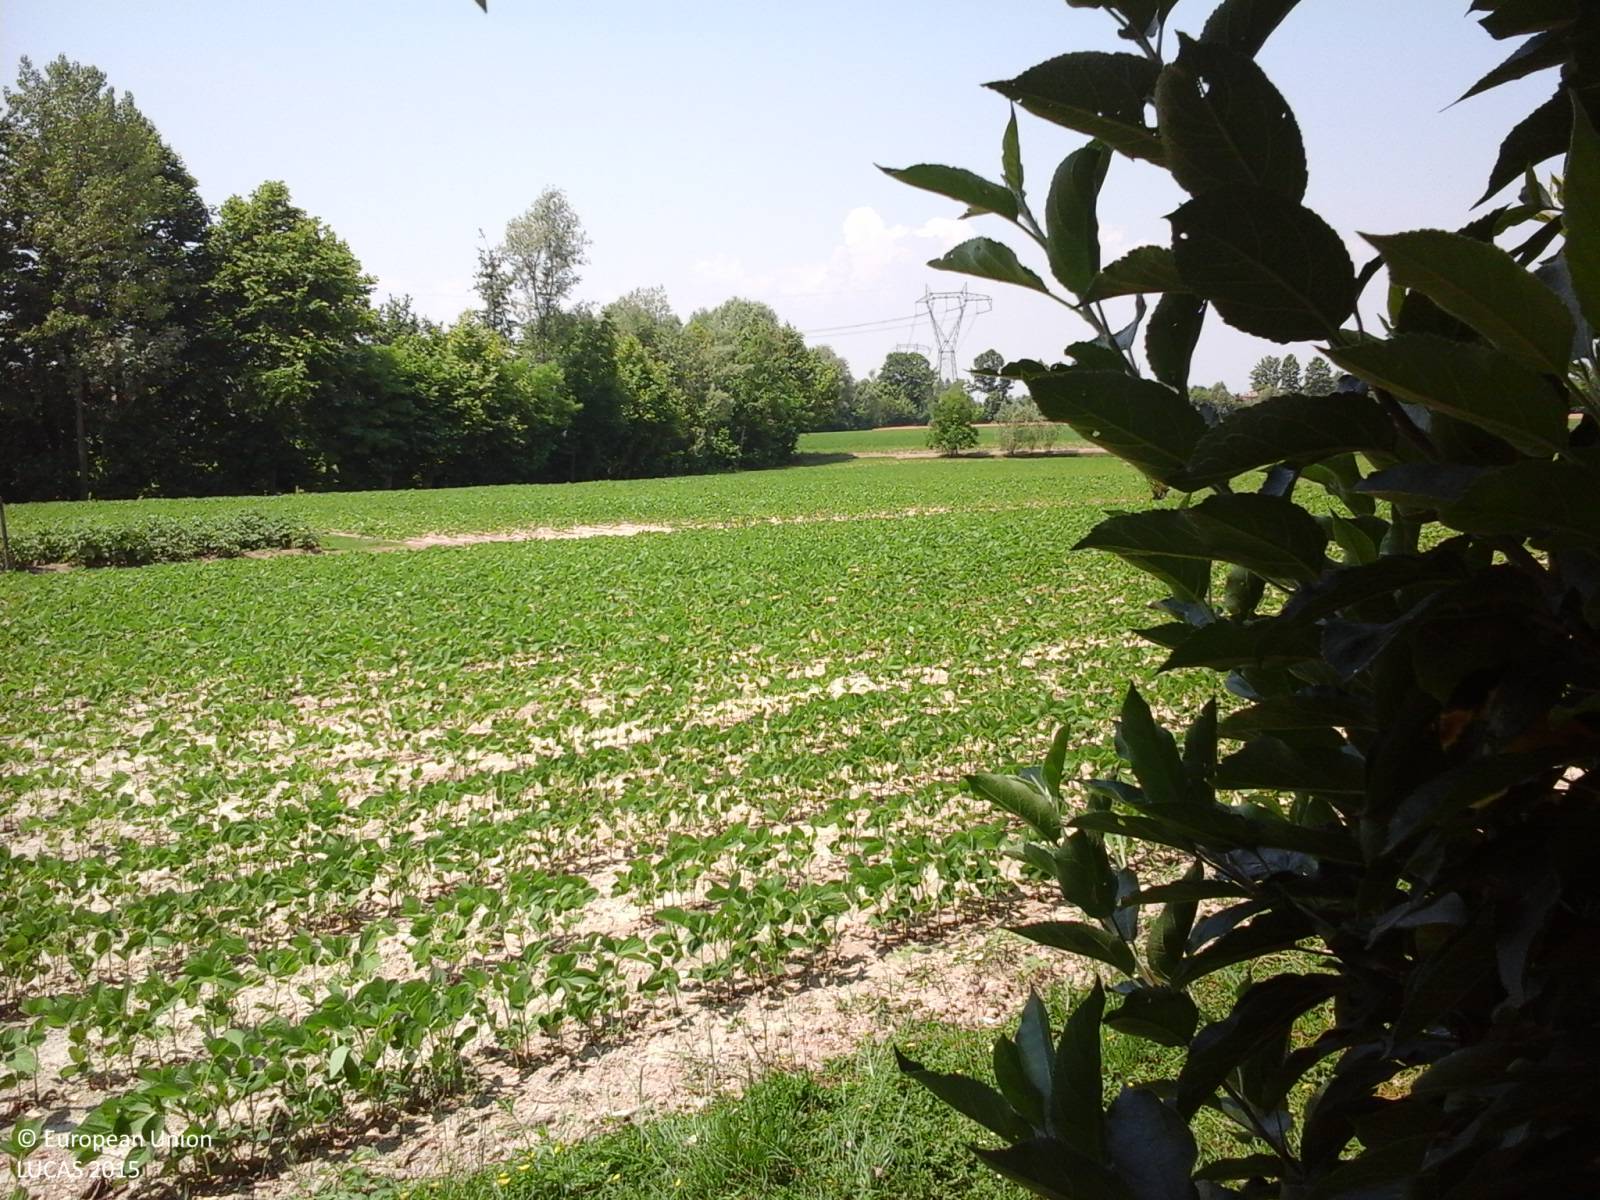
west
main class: Cropland
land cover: Nuts trees
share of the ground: 25 - 50 %
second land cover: Cherry fruit
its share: 25 - 50 %
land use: Kitchen garden
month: June
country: IT
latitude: 45.9240
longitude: 12.5627
